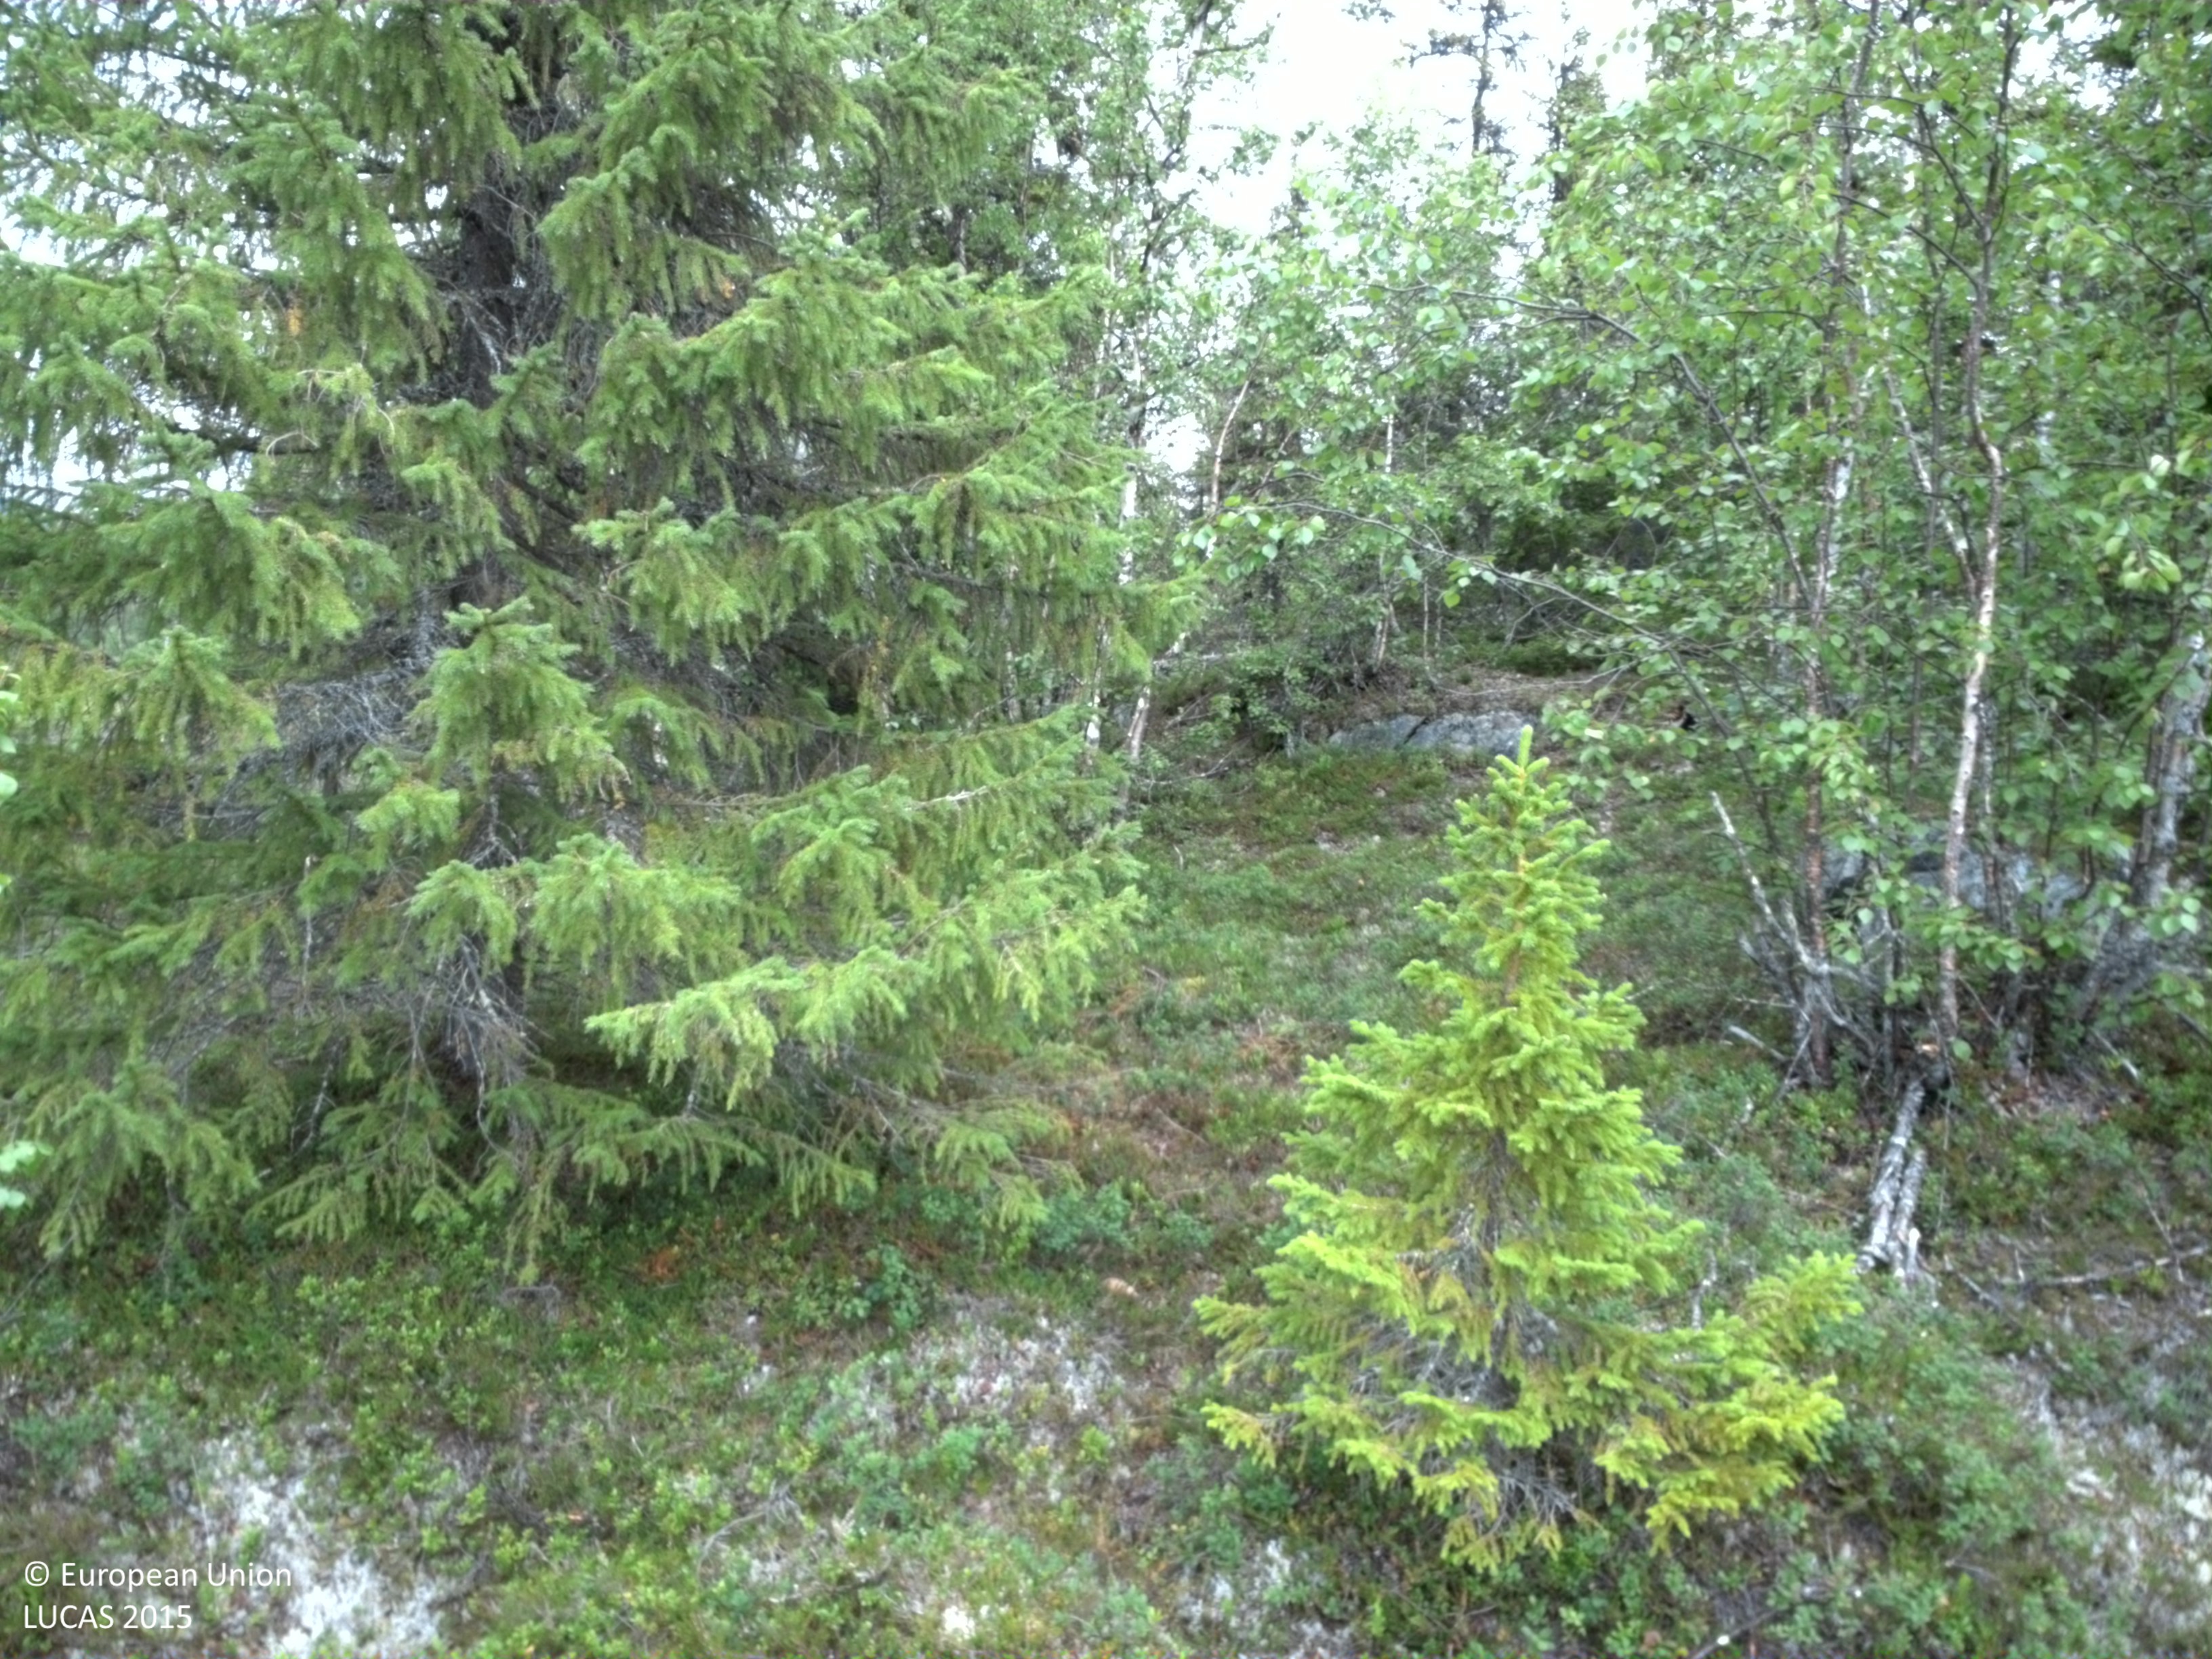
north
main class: Woodland
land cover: Spruce dominated mixed woodland
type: boreal forest
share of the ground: 25 - 50 %
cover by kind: shrubs 55 %, lichens and mosses 20 %, broadleaved forest trees 15 %, coniferous forest trees 10 %
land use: Semi-natural and natural areas not in use
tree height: > 5 m
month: August
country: SE
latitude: 65.0075
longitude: 15.5461
